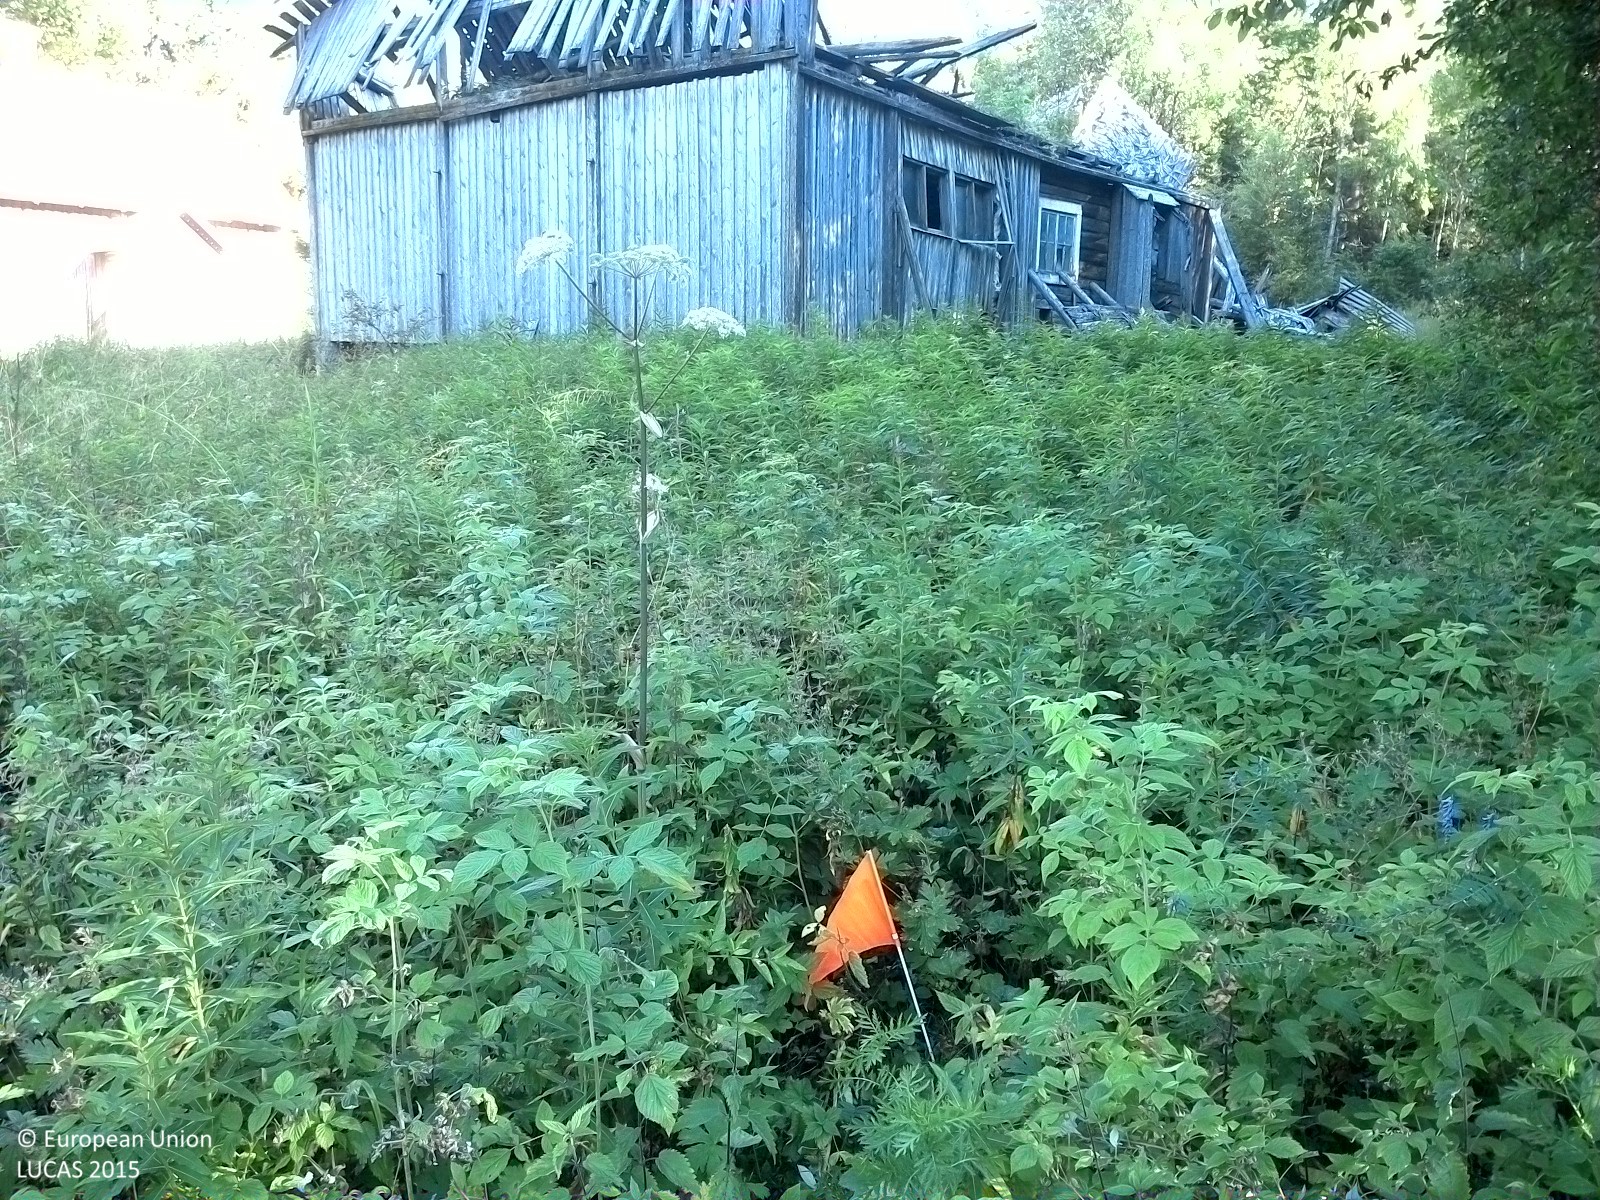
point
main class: Shrubland
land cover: Shrubland without tree cover
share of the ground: > 75 %
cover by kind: shrubs 50 %, herbaceous plants 50 %
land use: Residential
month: August
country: SE
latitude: 62.2578
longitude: 16.4314
